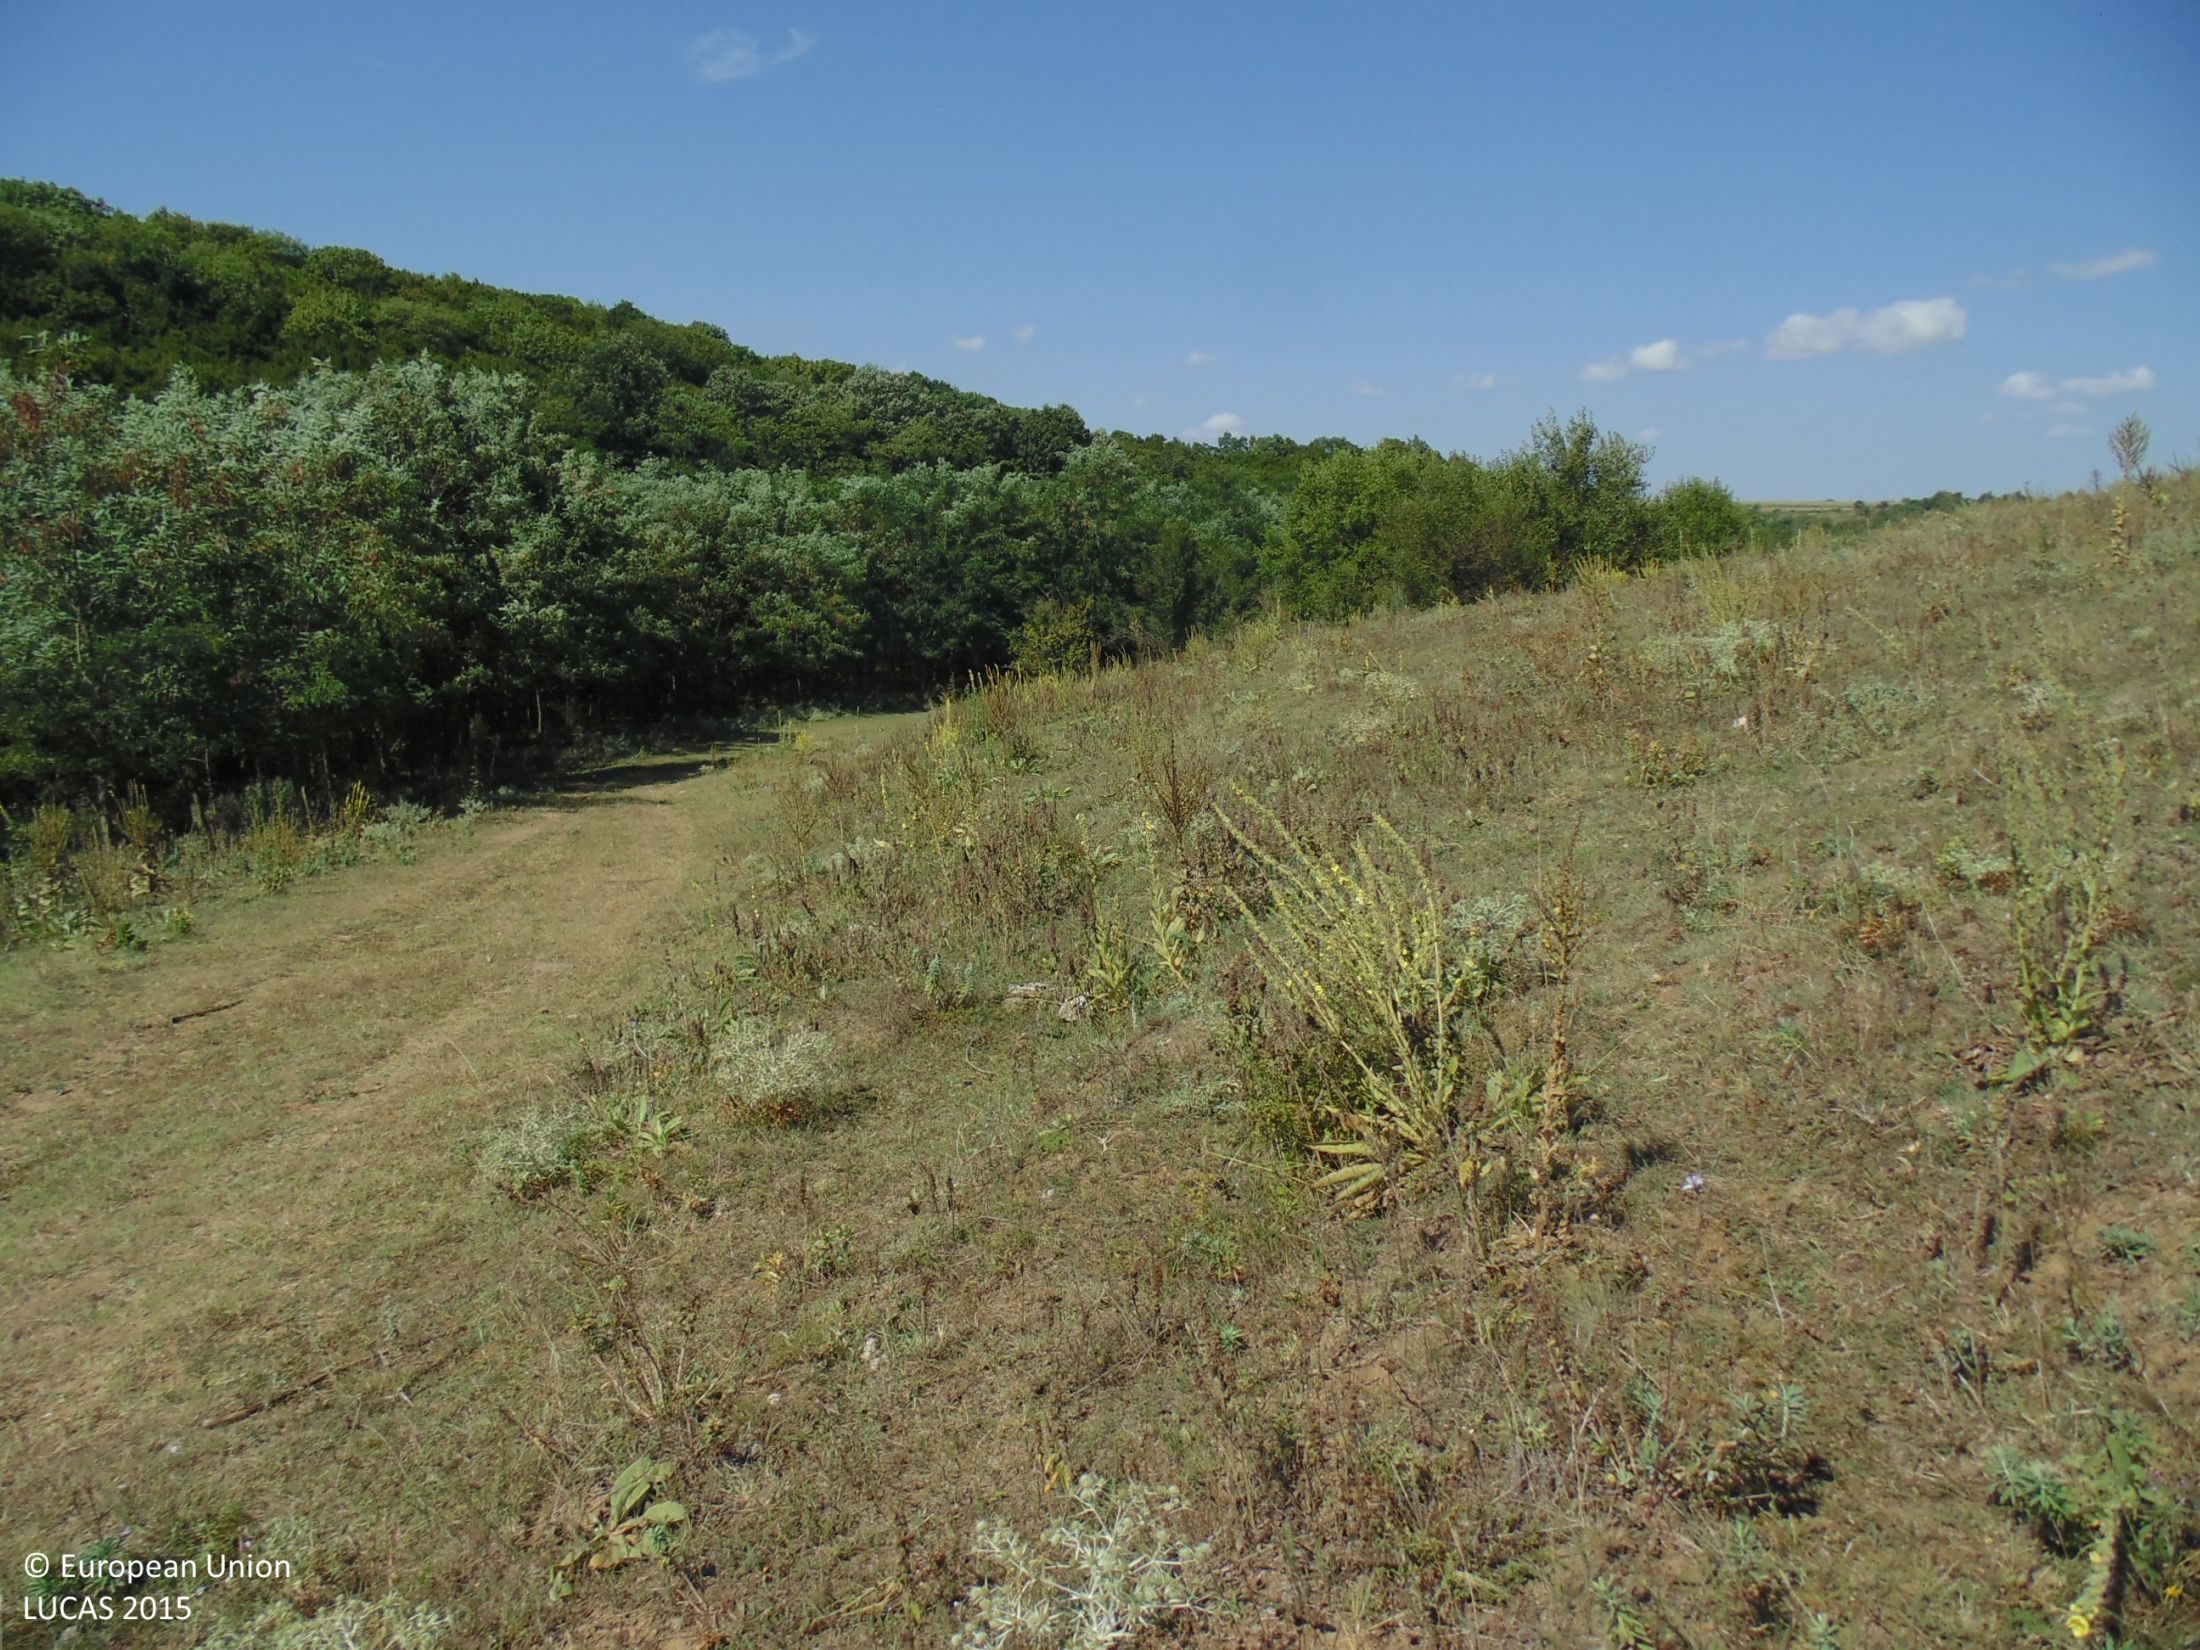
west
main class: Grassland
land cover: Grassland without tree/shrub cover
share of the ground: > 75 %
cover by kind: herbaceous plants 100 %
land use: Agriculture (excluding fallow land and kitchen gardens)
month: August
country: BG
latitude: 43.6397
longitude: 28.2406
